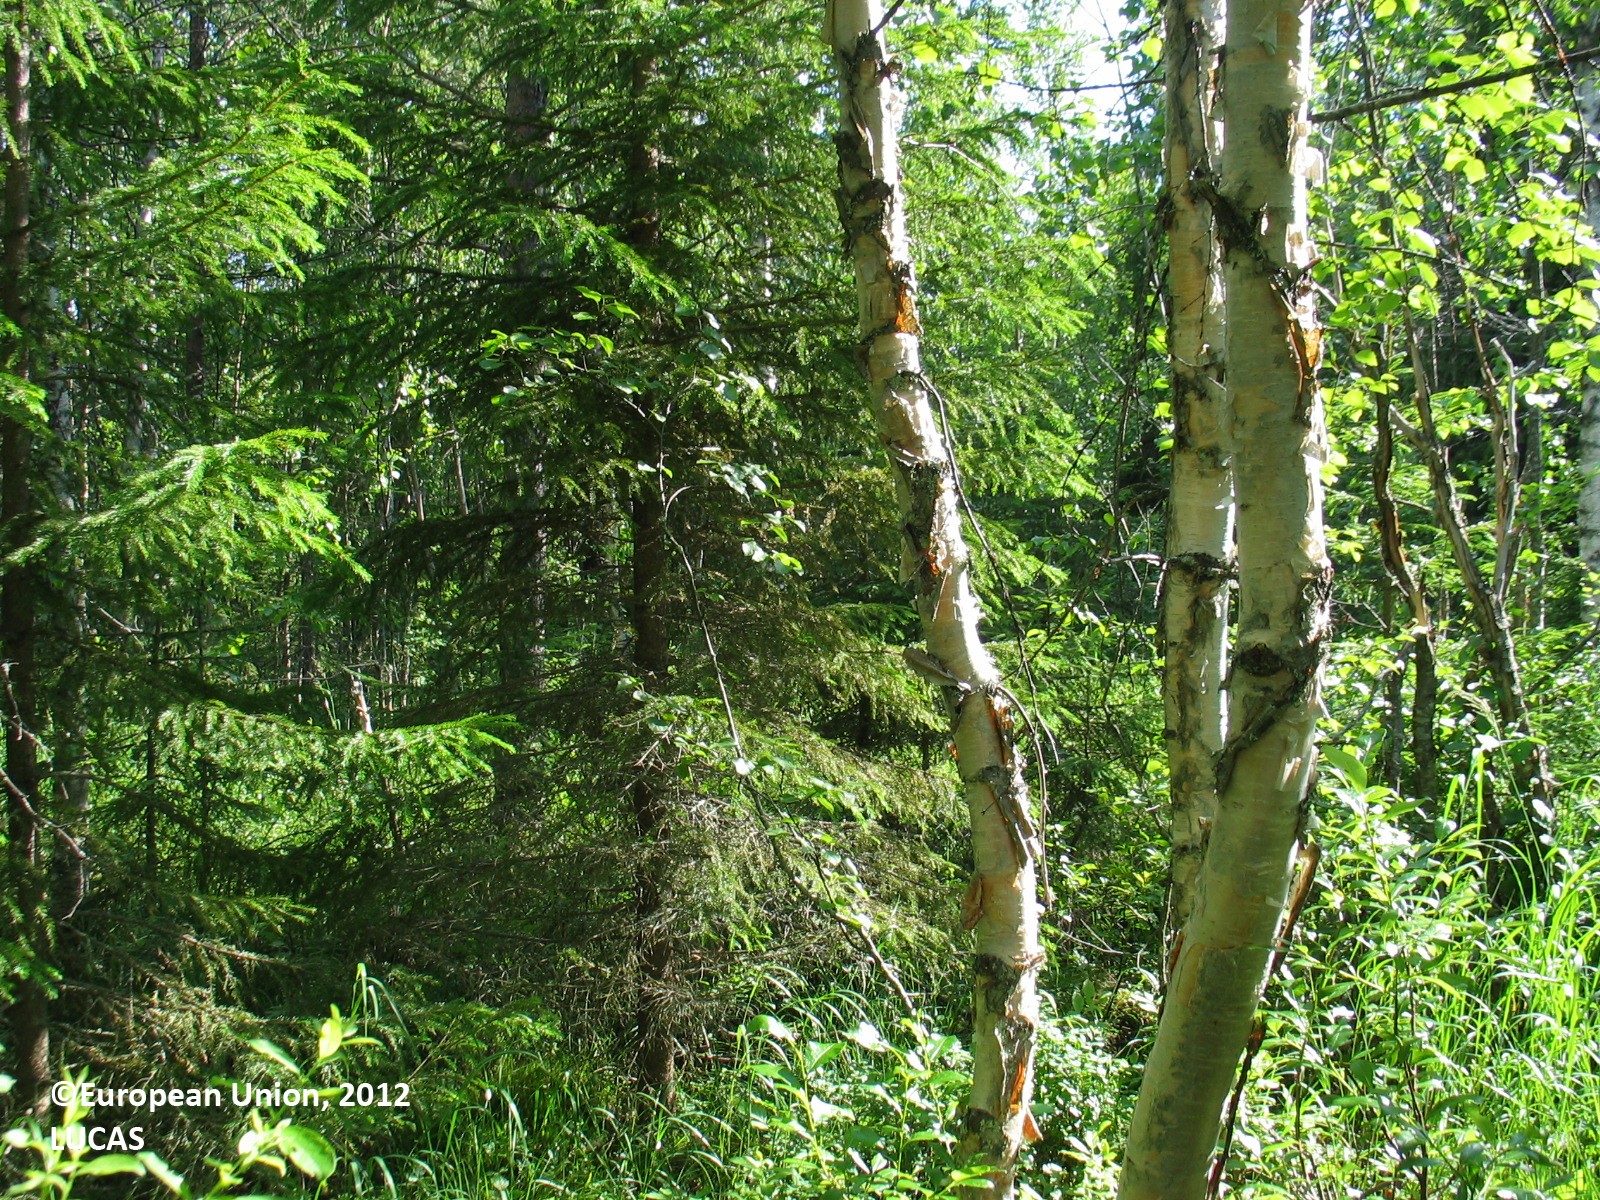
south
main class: Woodland
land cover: Broadleaved woodland
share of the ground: 50 - 75 %
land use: Forestry
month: July
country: FI
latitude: 65.9410
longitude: 25.1217
